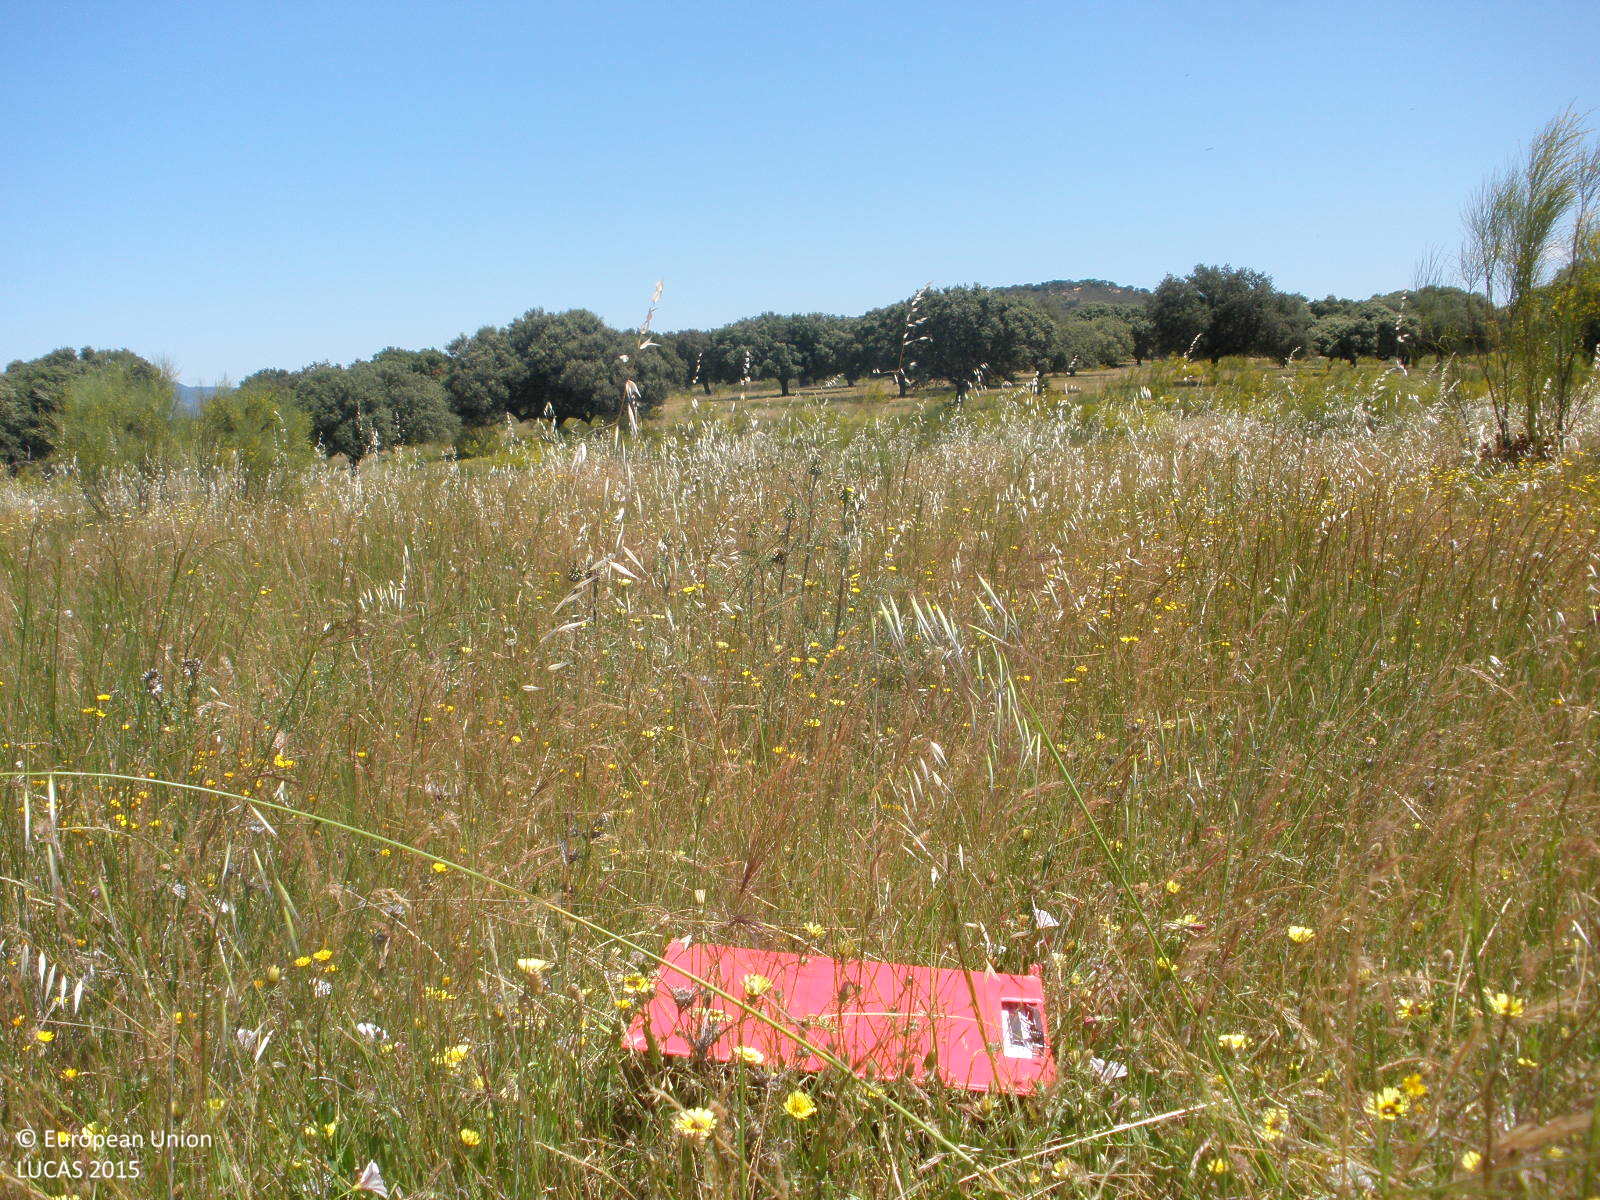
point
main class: Shrubland
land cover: Shrubland without tree cover
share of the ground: > 75 %
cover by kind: herbaceous plants 80 %, shrubs 20 %
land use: Agriculture (excluding fallow land and kitchen gardens)
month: May
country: ES
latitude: 40.1961
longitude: -6.1091
